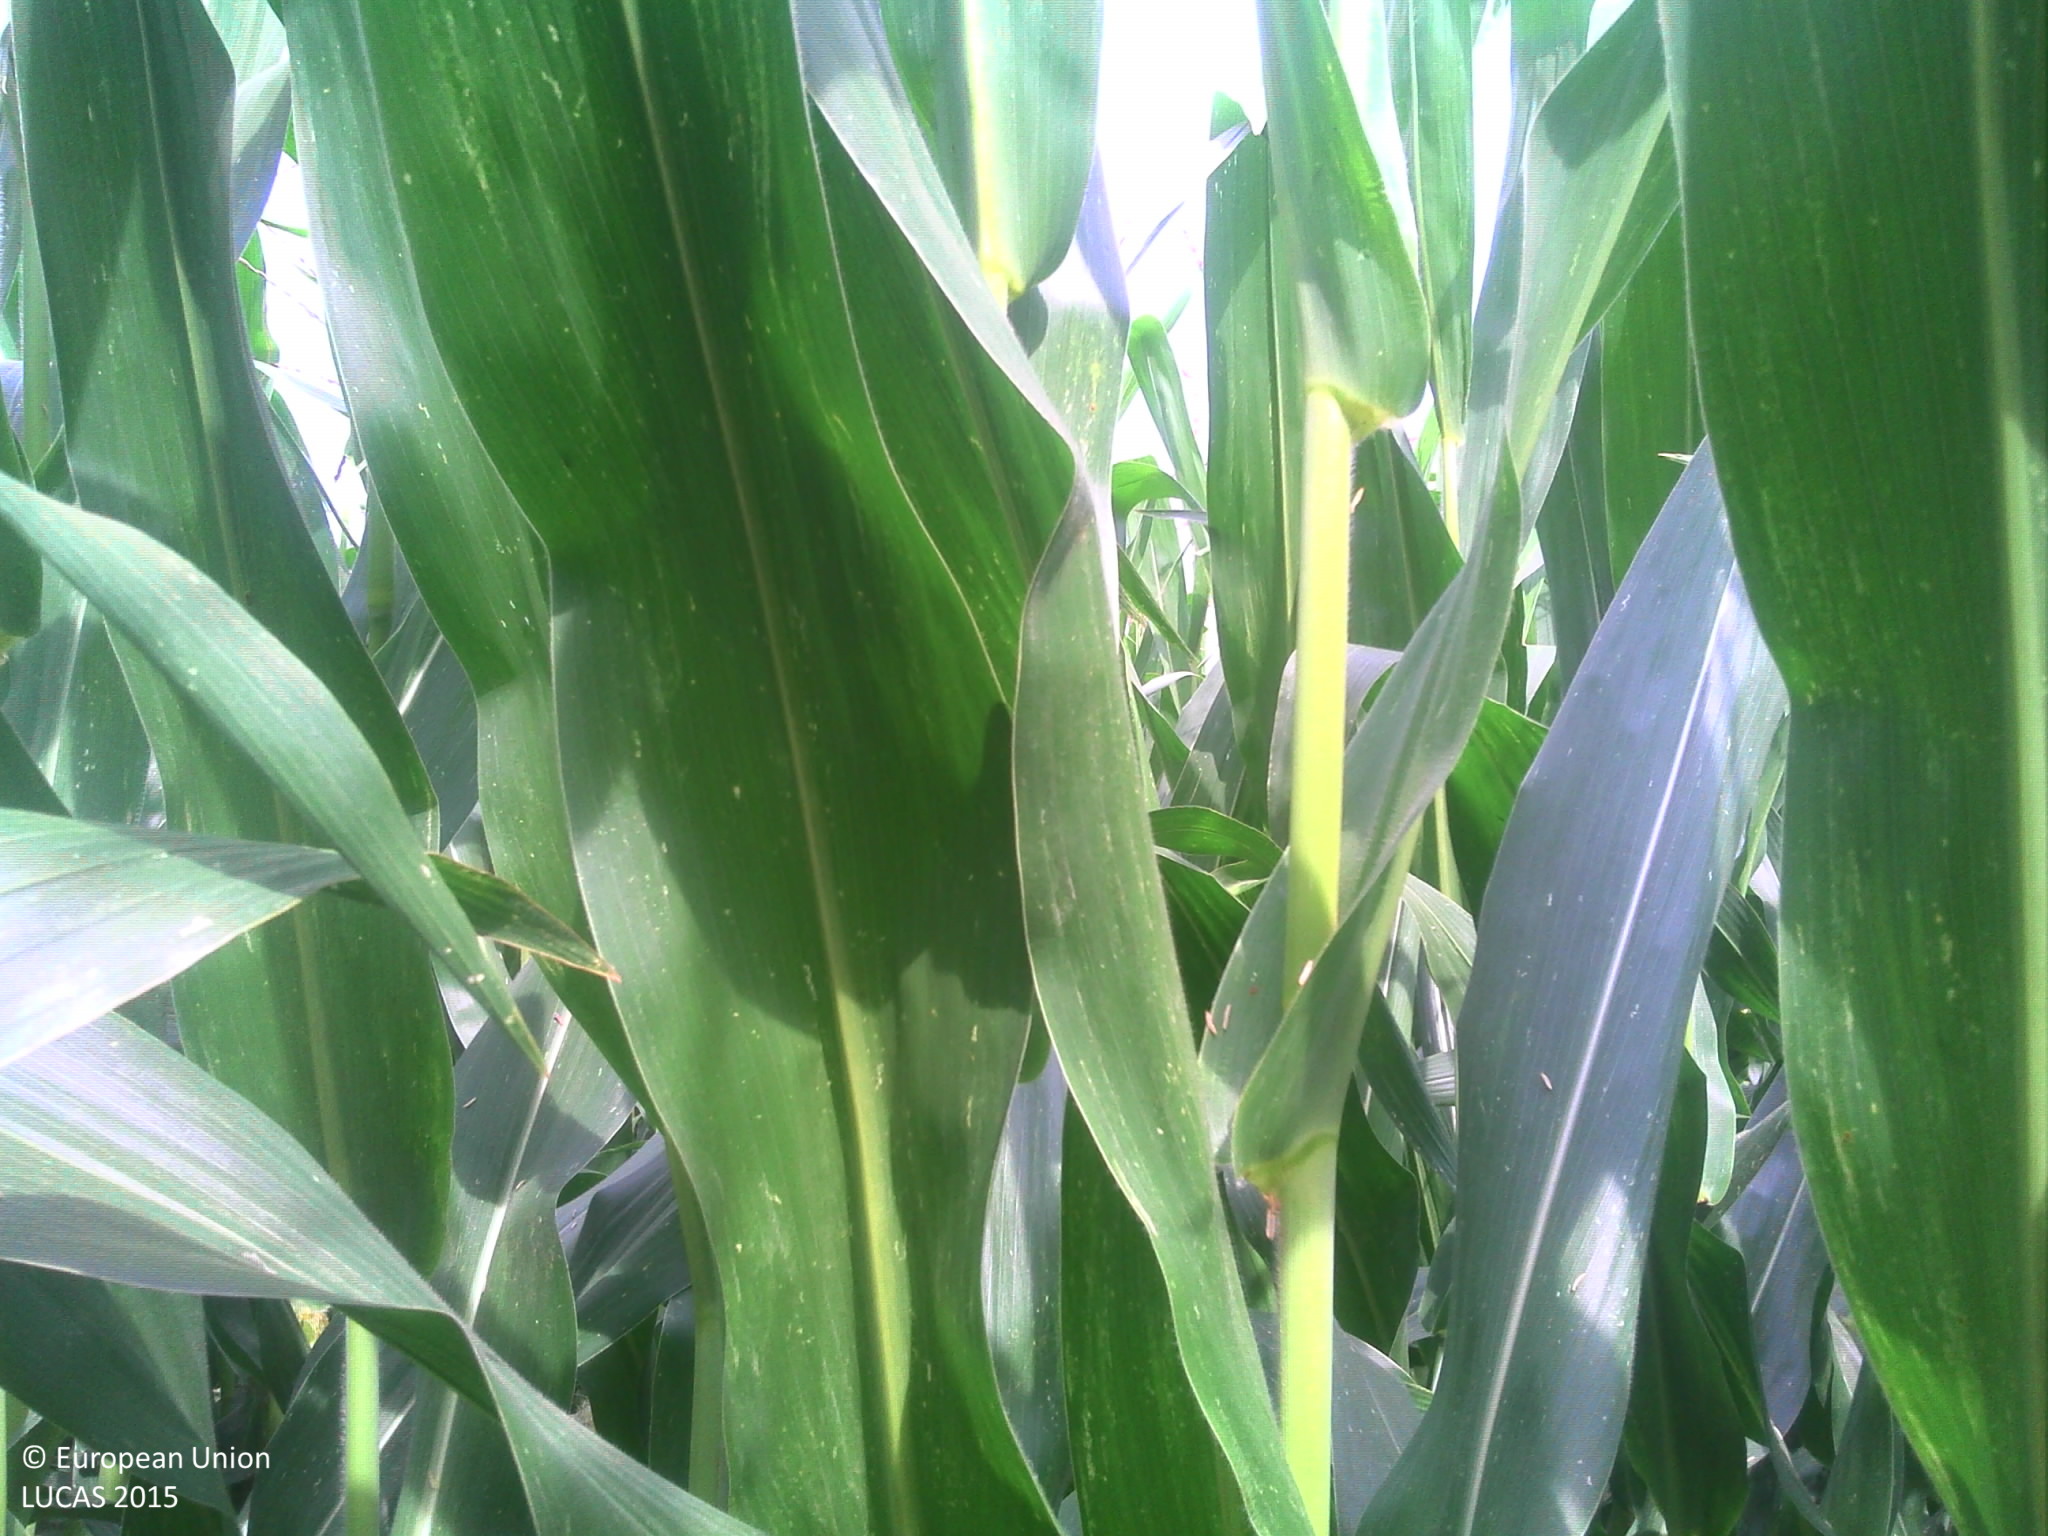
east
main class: Cropland
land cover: Maize
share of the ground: > 75 %
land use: Agriculture (excluding fallow land and kitchen gardens)
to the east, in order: Maize; Grass margins; Ditches and canals; Grass margins; Paved roads, cycling and walking lanes; Grass margins; Ditches and canals; Sunflower; Grass margins; Ditches and canals; Grass margins; Paved roads, cycling and walking lanes; Grass margins; Ditches and canals; Grass margins; Common wheat
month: July
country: FR
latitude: 43.3914
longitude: 1.1507
